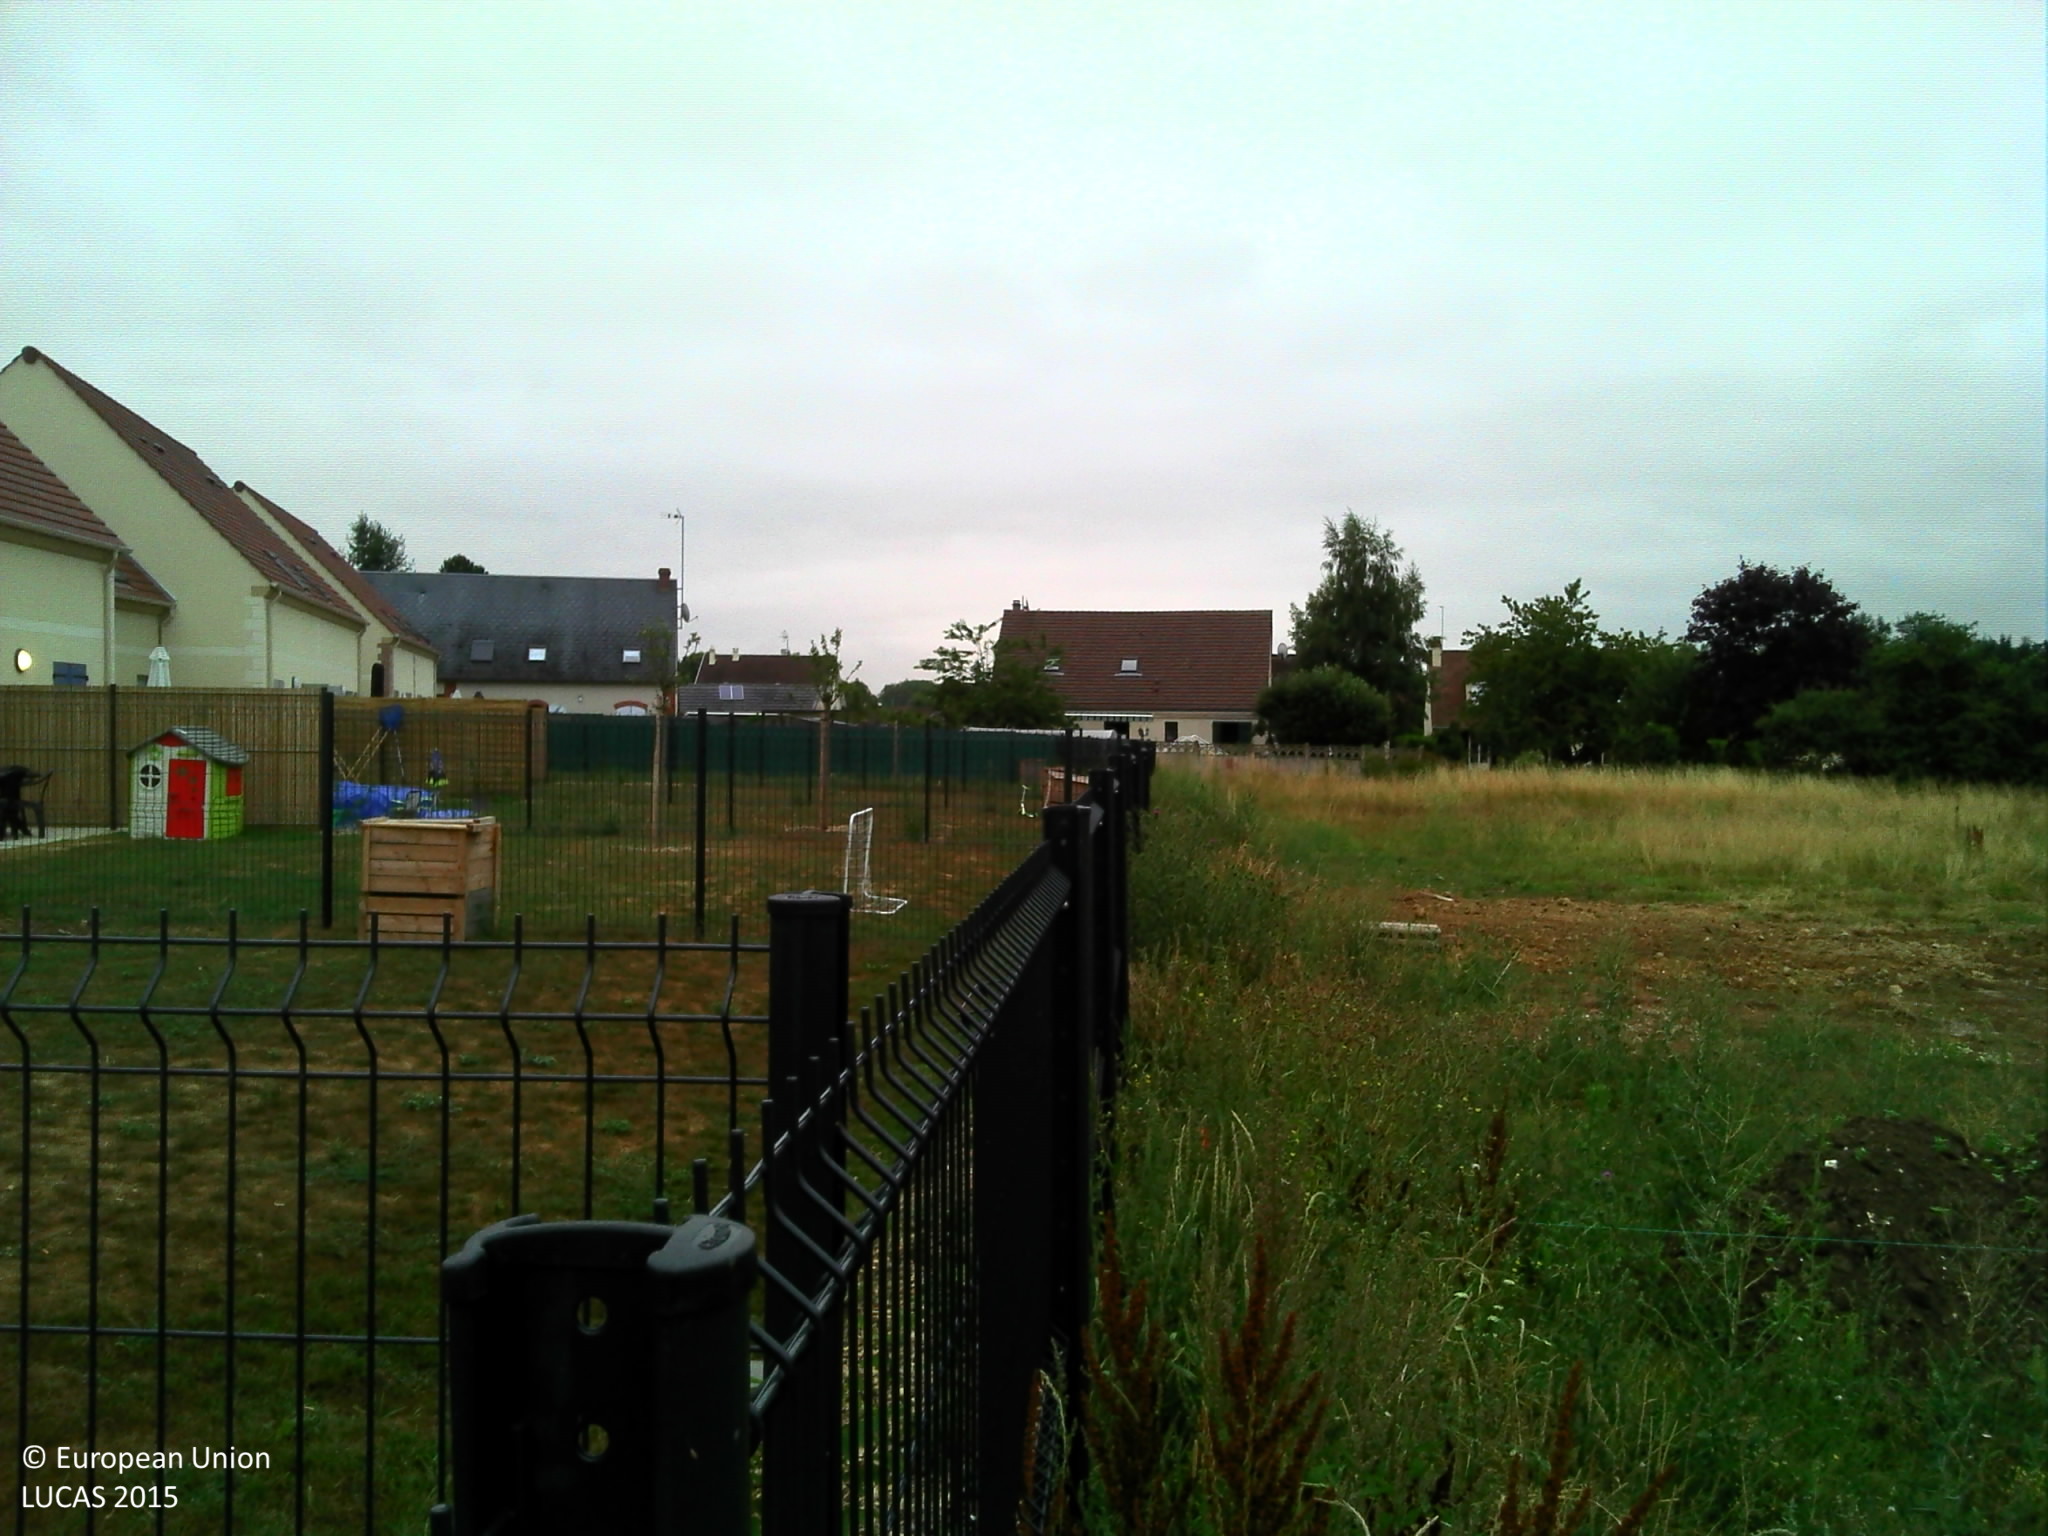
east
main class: Grassland
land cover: Grassland with sparse tree/shrub cover
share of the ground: > 75 %
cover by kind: herbaceous plants 95 %, broadleaved forest trees 5 %
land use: Residential
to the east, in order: Grassland with sparse tree/shrub cover; Artificial constructions in urban areas
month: July
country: FR
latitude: 49.3901
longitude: 2.4241
